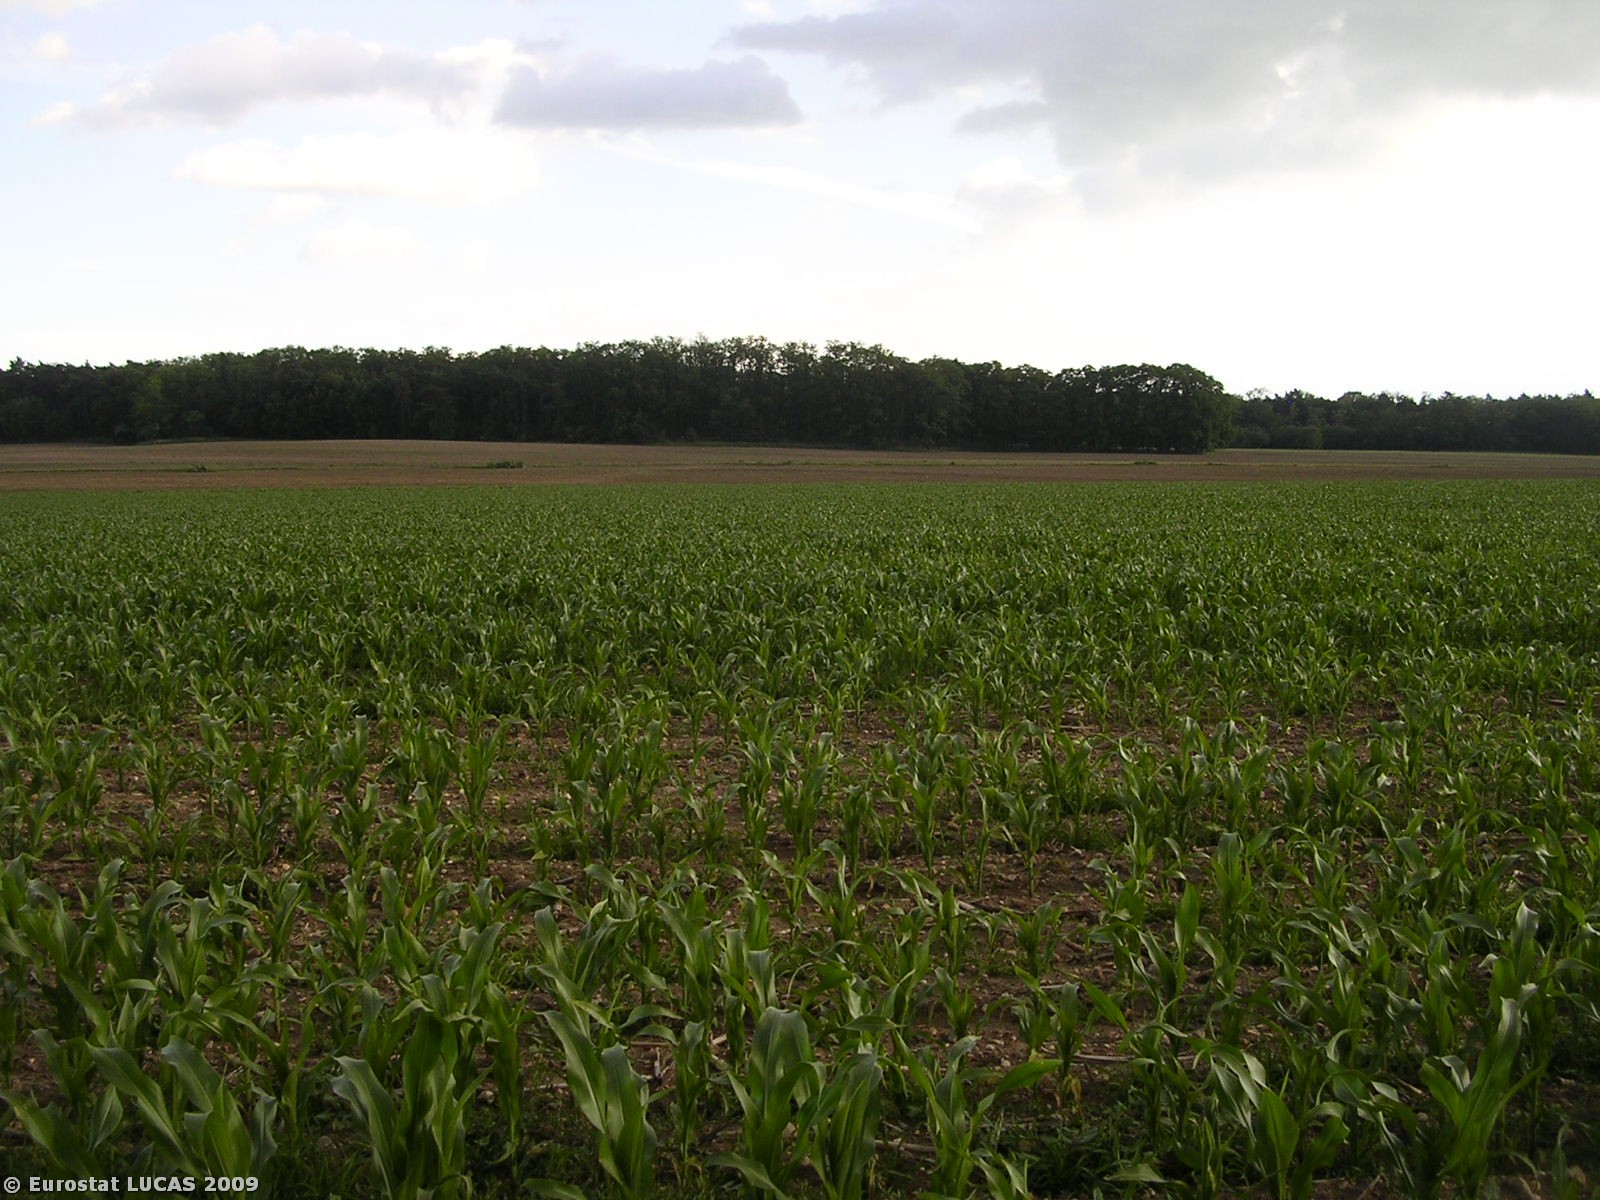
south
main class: Cropland
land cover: Maize
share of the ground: 25 - 50 %
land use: Agriculture (excluding fallow land and kitchen gardens)
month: June
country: CZ
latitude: 50.4824
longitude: 14.2716
